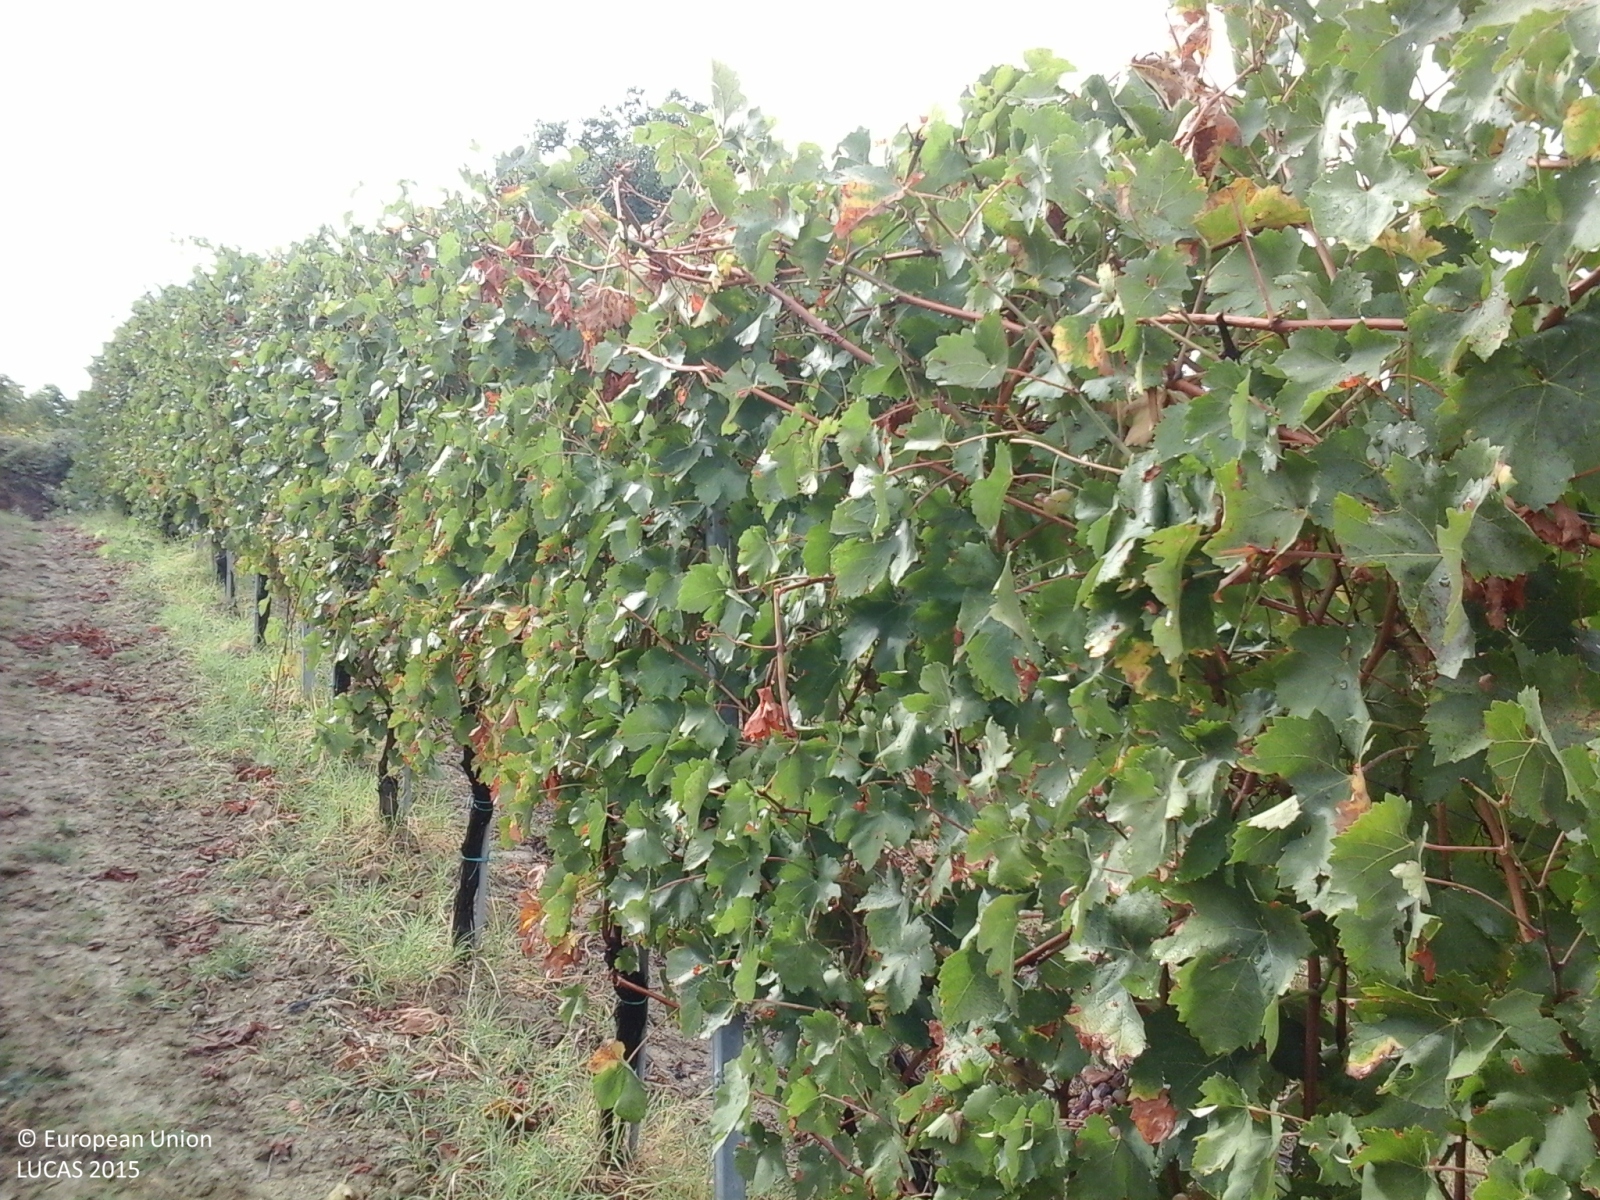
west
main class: Cropland
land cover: Vineyards
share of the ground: 50 - 75 %
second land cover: Other bare soil
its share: > 75 %
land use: Agriculture (excluding fallow land and kitchen gardens)
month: September
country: IT
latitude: 43.4364
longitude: 13.1424
